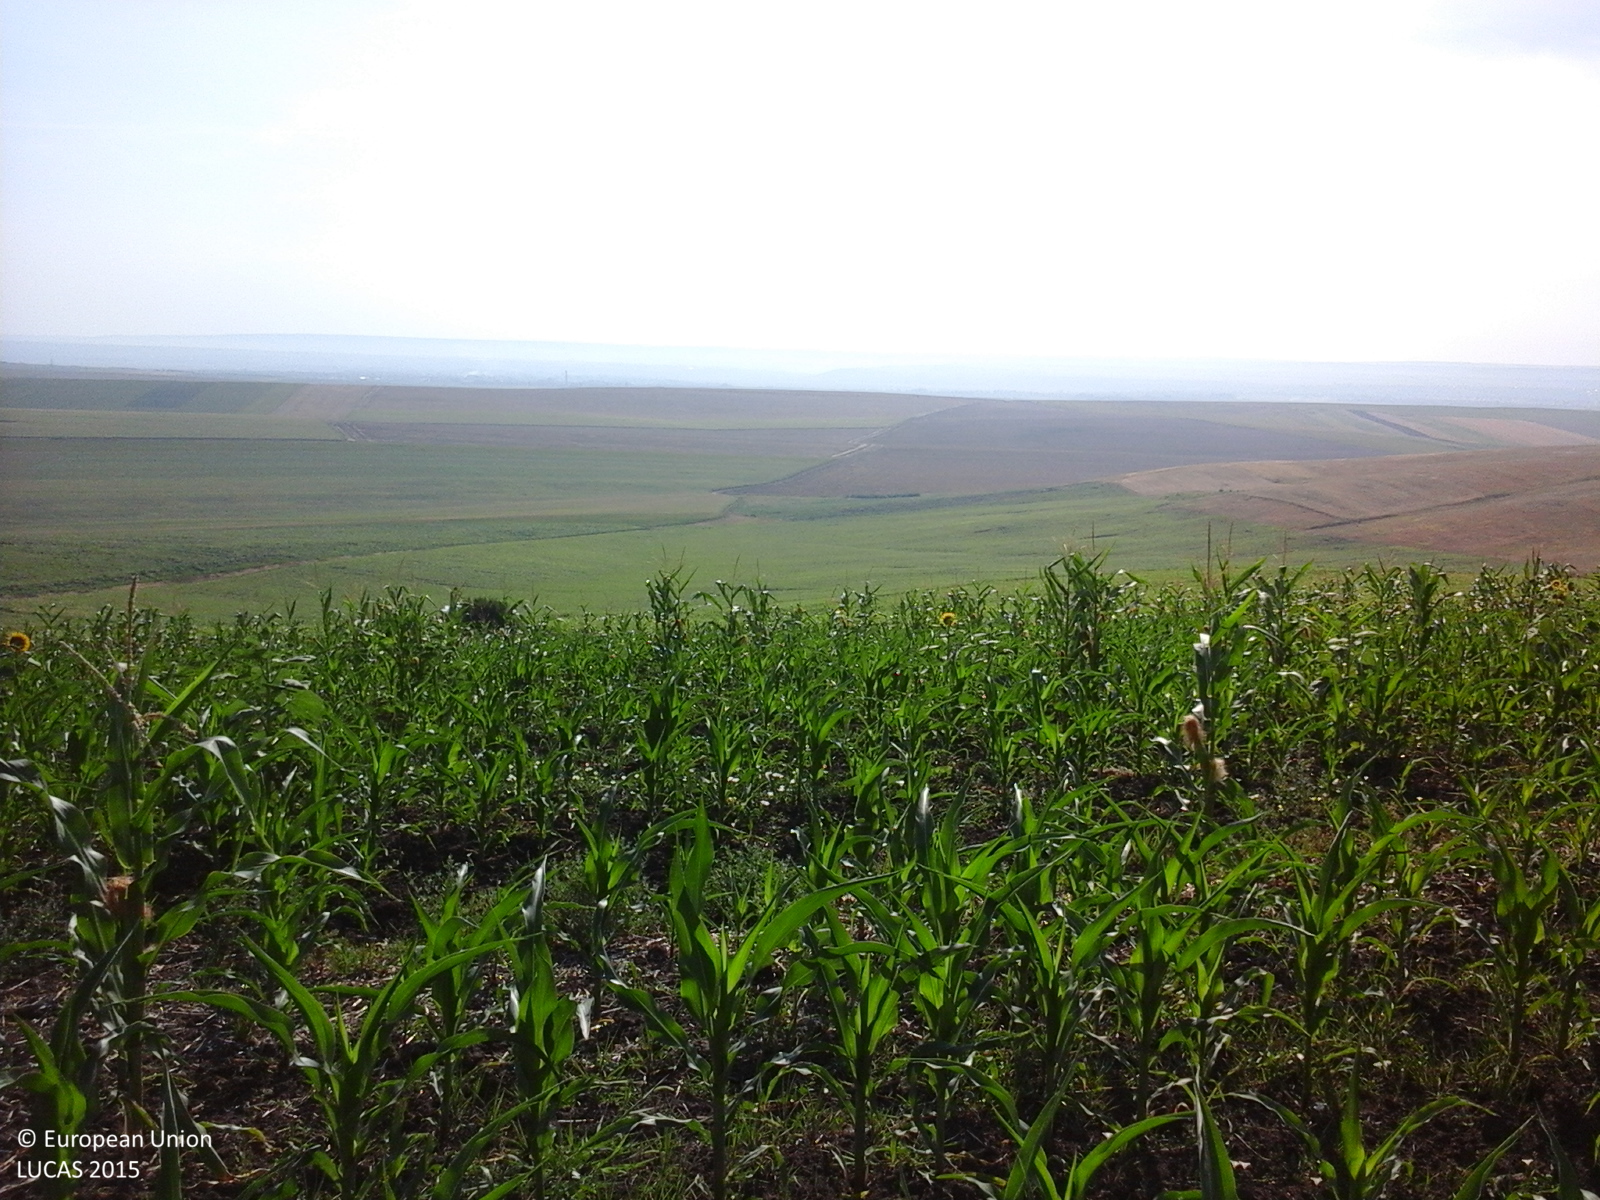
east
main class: Cropland
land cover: Maize
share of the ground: 50 - 75 %
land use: Agriculture (excluding fallow land and kitchen gardens)
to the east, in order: Maize; Shruby margins; Ditches and canals; Shruby margins; Maize; Sunflower
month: July
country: RO
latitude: 46.2747
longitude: 28.0470
